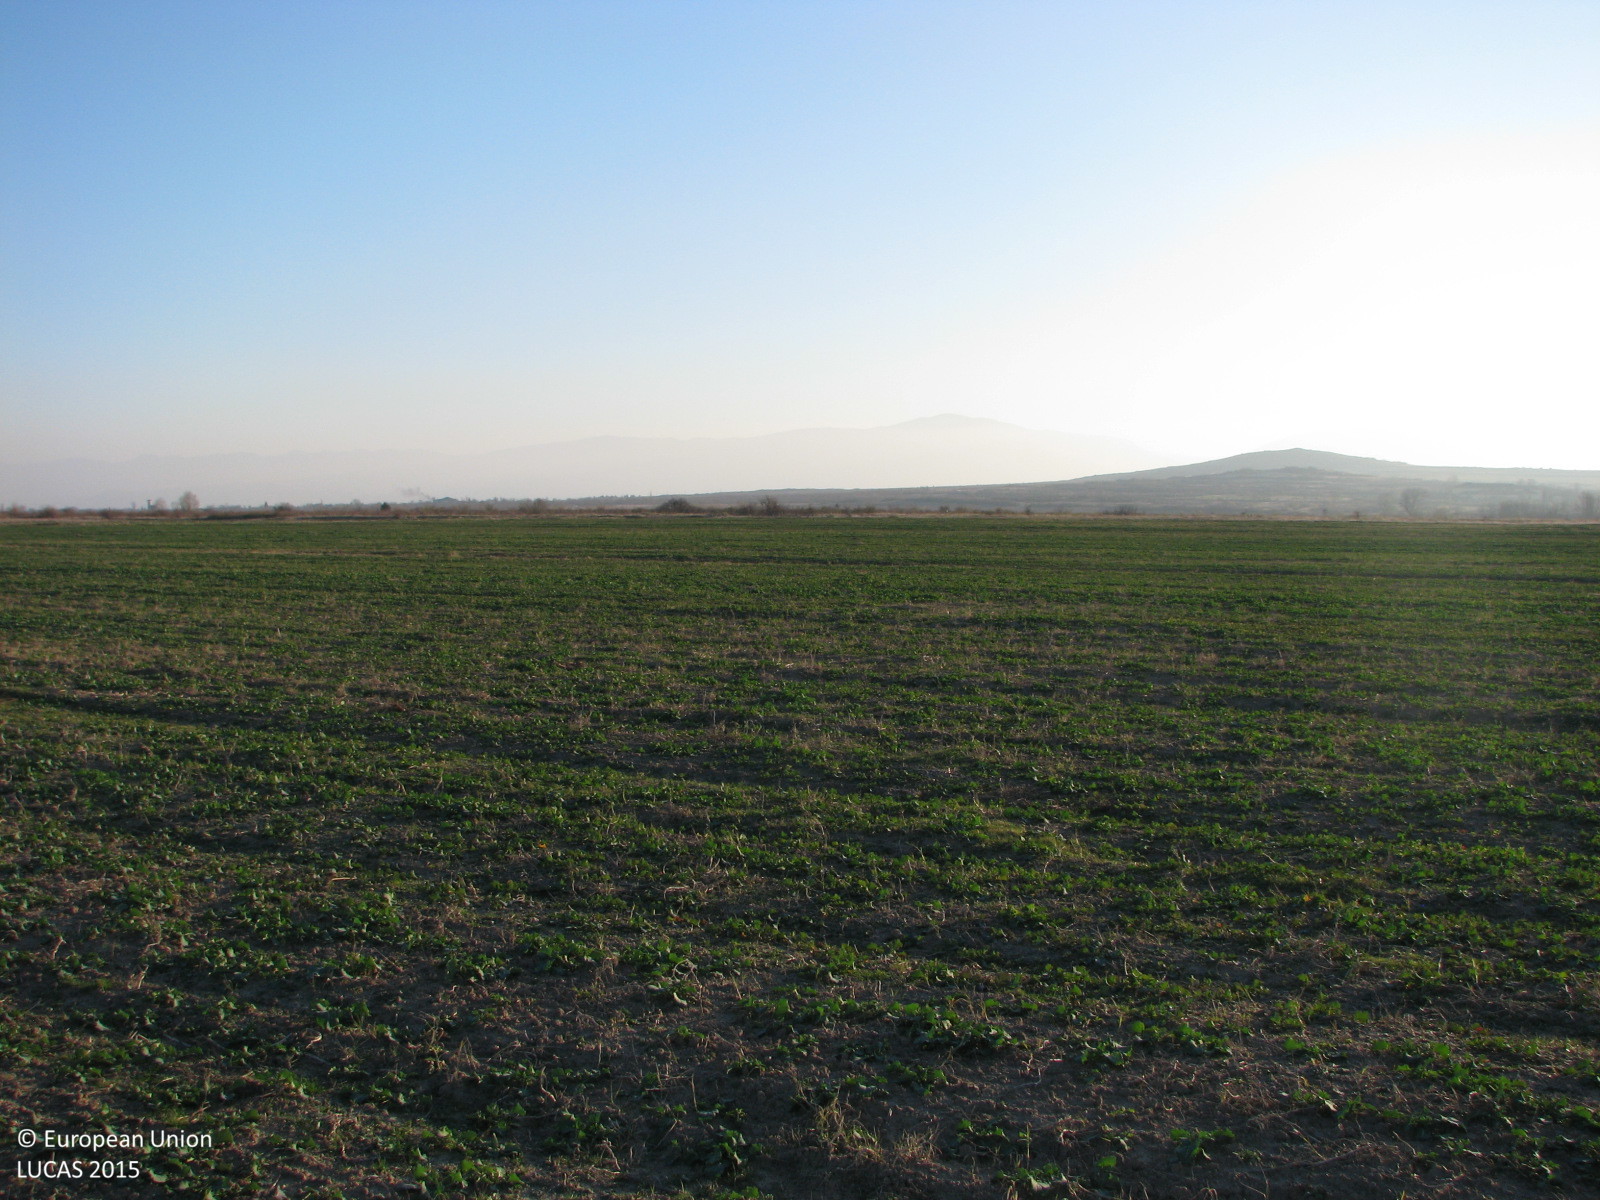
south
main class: Cropland
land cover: Rape and turnip rape
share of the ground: 25 - 50 %
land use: Agriculture (excluding fallow land and kitchen gardens)
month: December
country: BG
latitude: 42.2958
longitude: 24.1490
